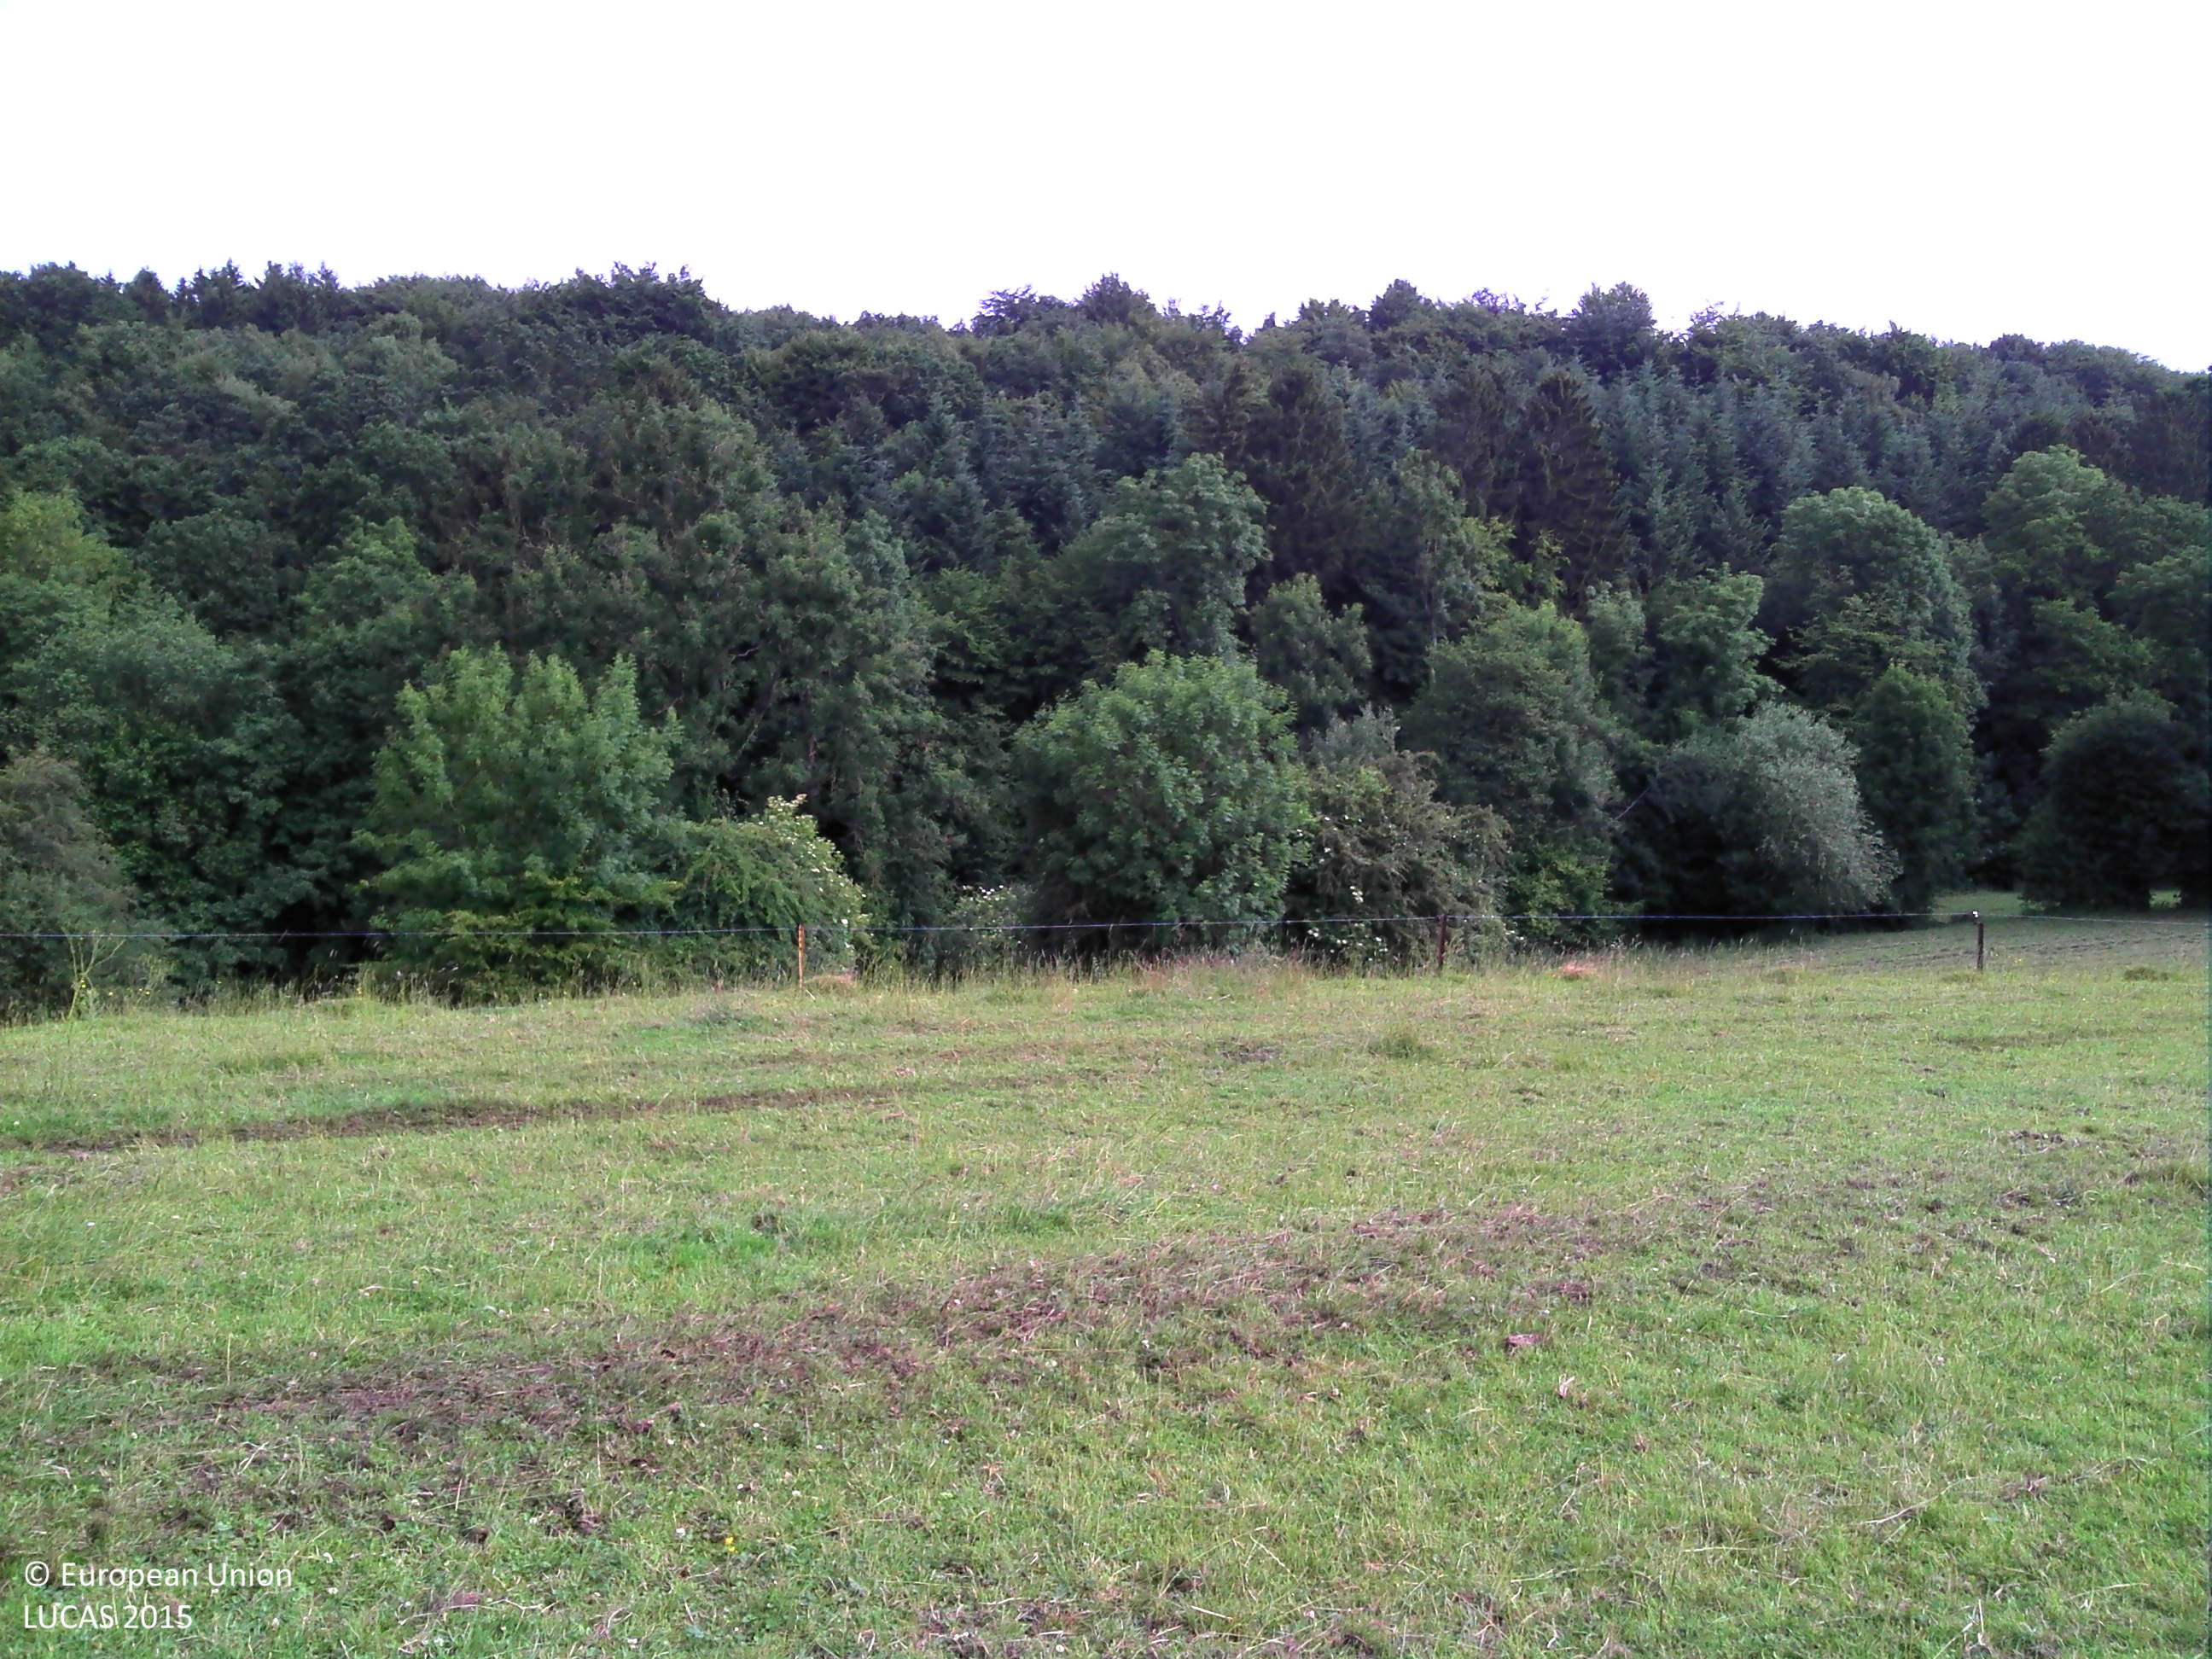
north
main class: Grassland
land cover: Grassland without tree/shrub cover
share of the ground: > 75 %
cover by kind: herbaceous plants 100 %
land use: Agriculture (excluding fallow land and kitchen gardens)
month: June
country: BE
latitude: 50.5097
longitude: 5.4999
